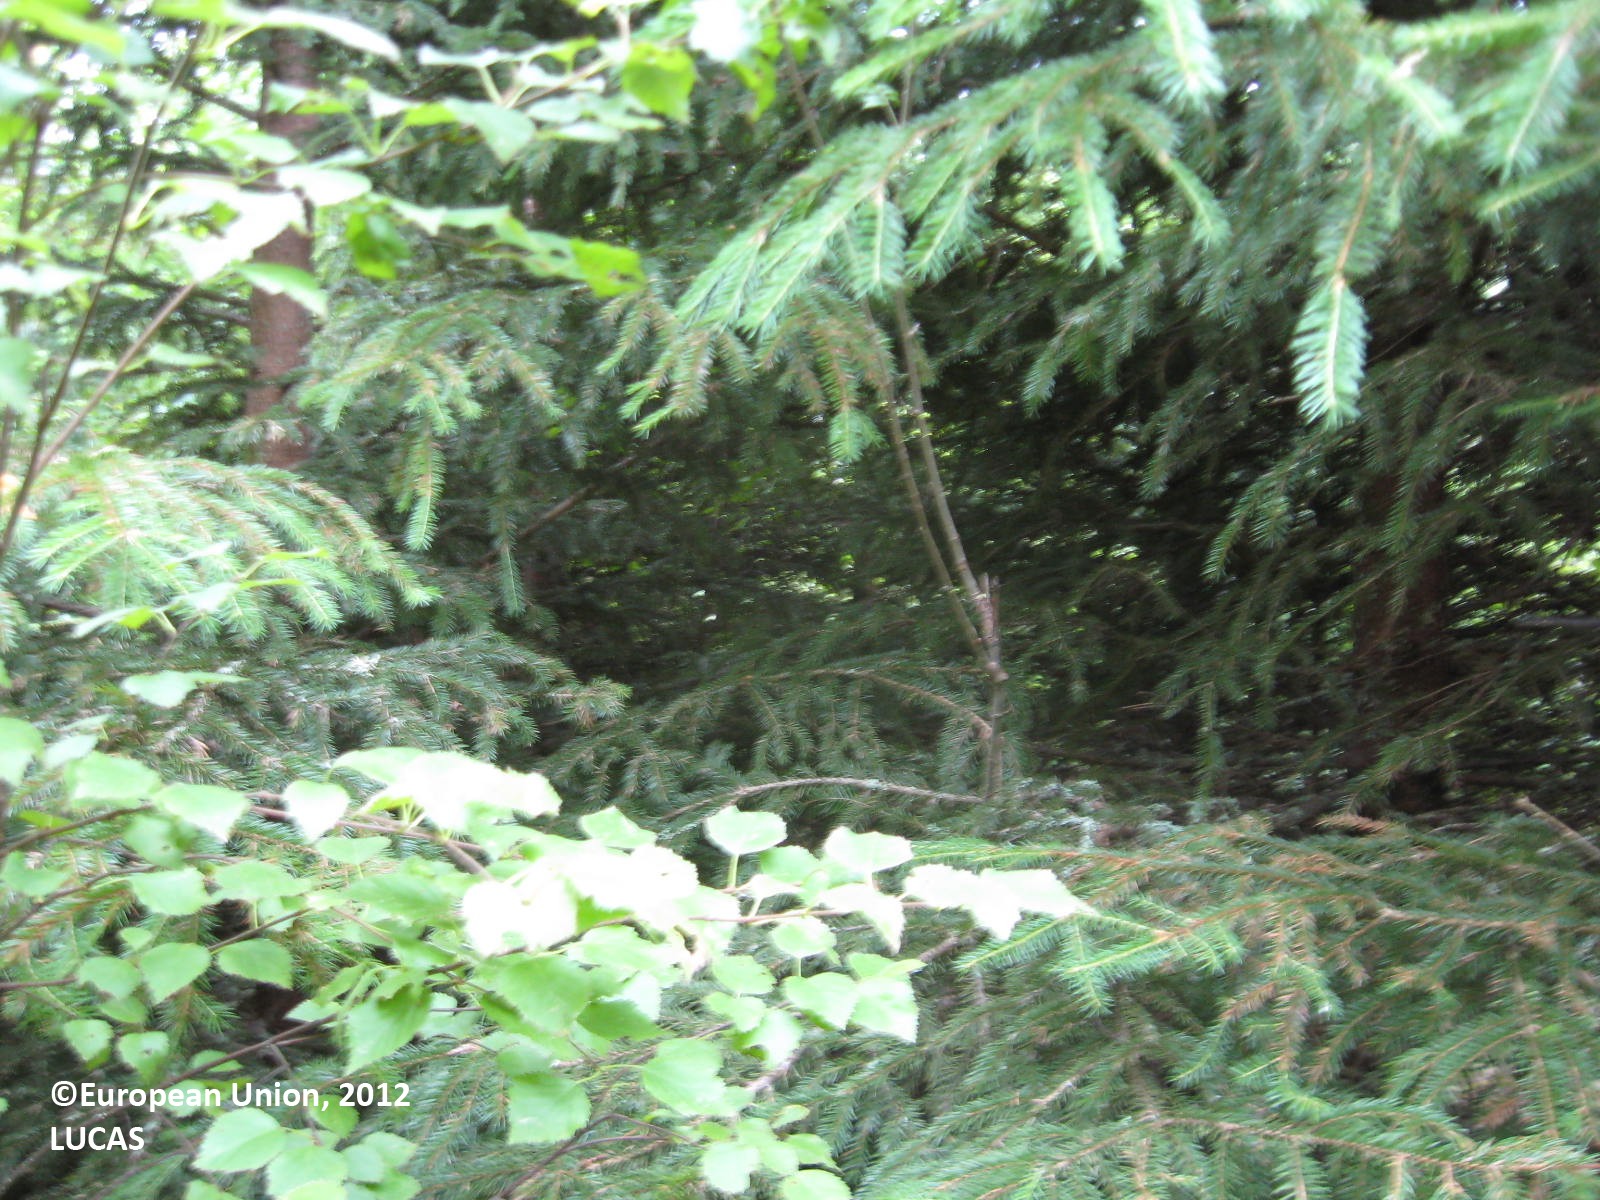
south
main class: Woodland
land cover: Other mixed woodland
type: boreal forest
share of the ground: > 75 %
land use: Forestry
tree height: > 5 m
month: July
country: FI
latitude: 61.8387
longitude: 21.5396
